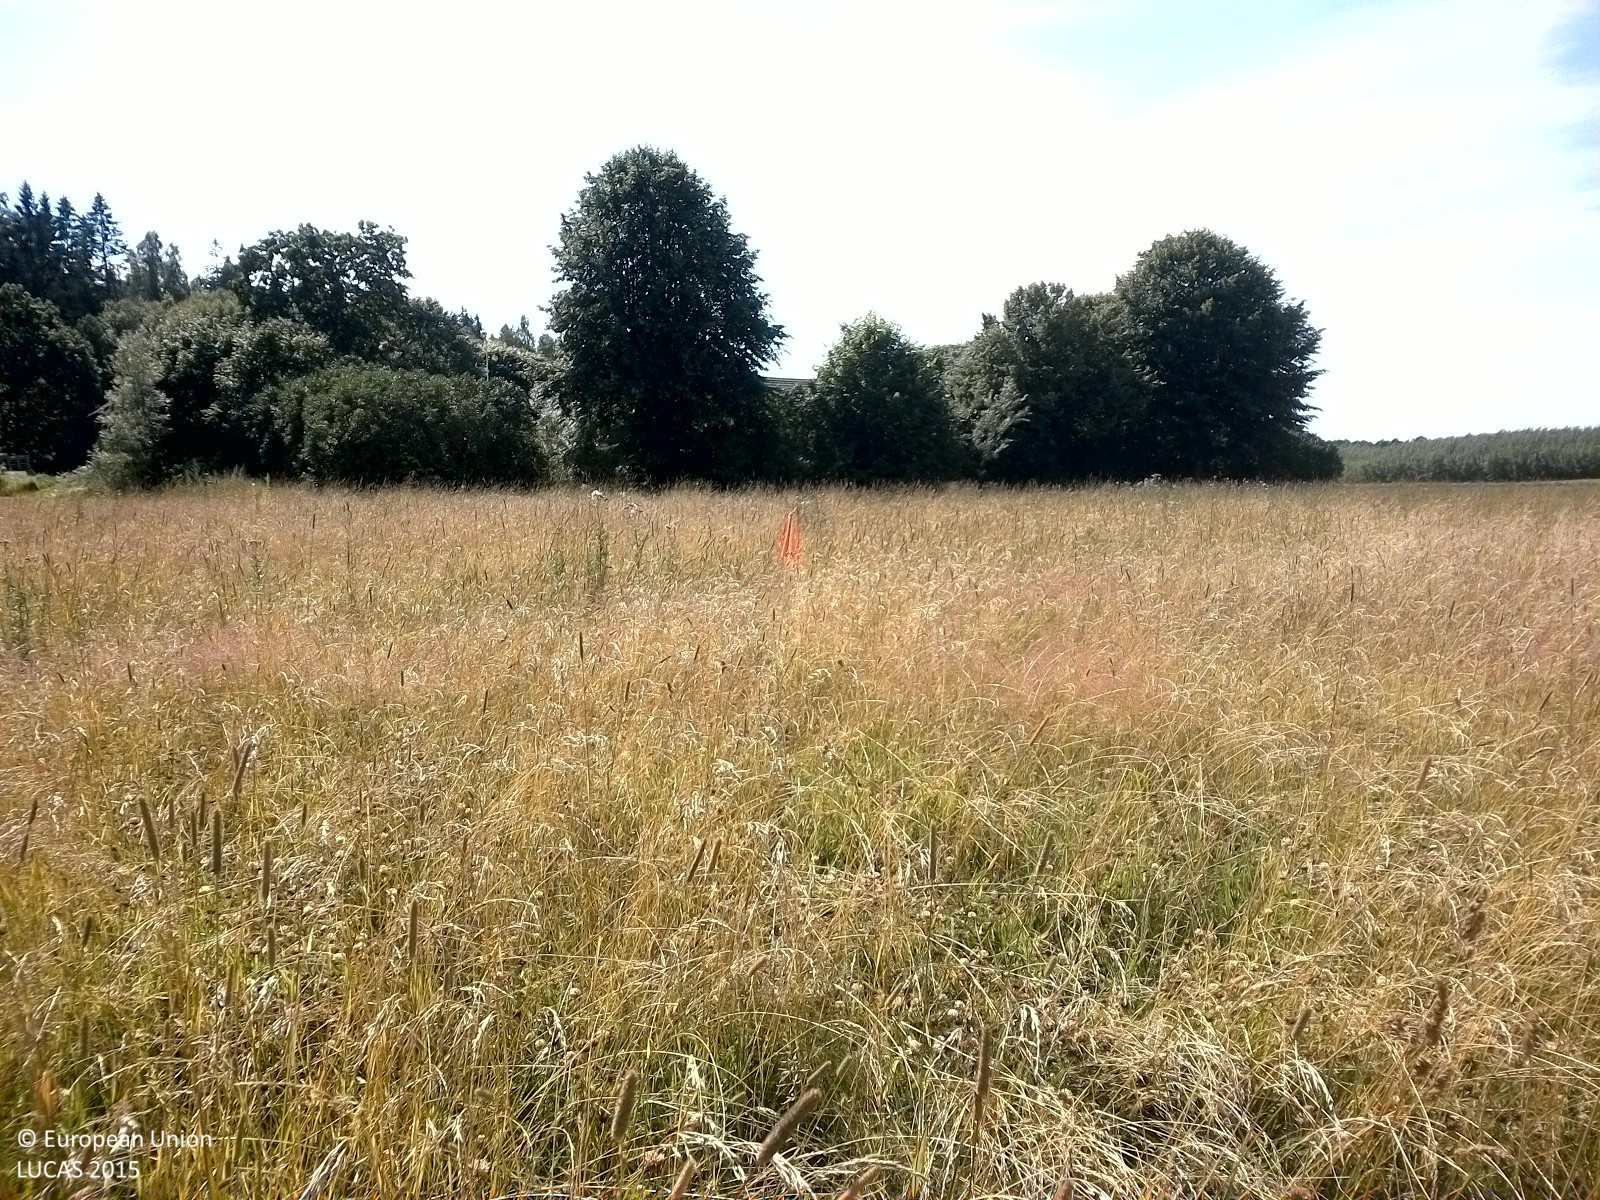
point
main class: Grassland
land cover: Grassland without tree/shrub cover
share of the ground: > 75 %
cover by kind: herbaceous plants 100 %
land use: Agriculture (excluding fallow land and kitchen gardens)
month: August
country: SE
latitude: 58.7221
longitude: 14.9837
